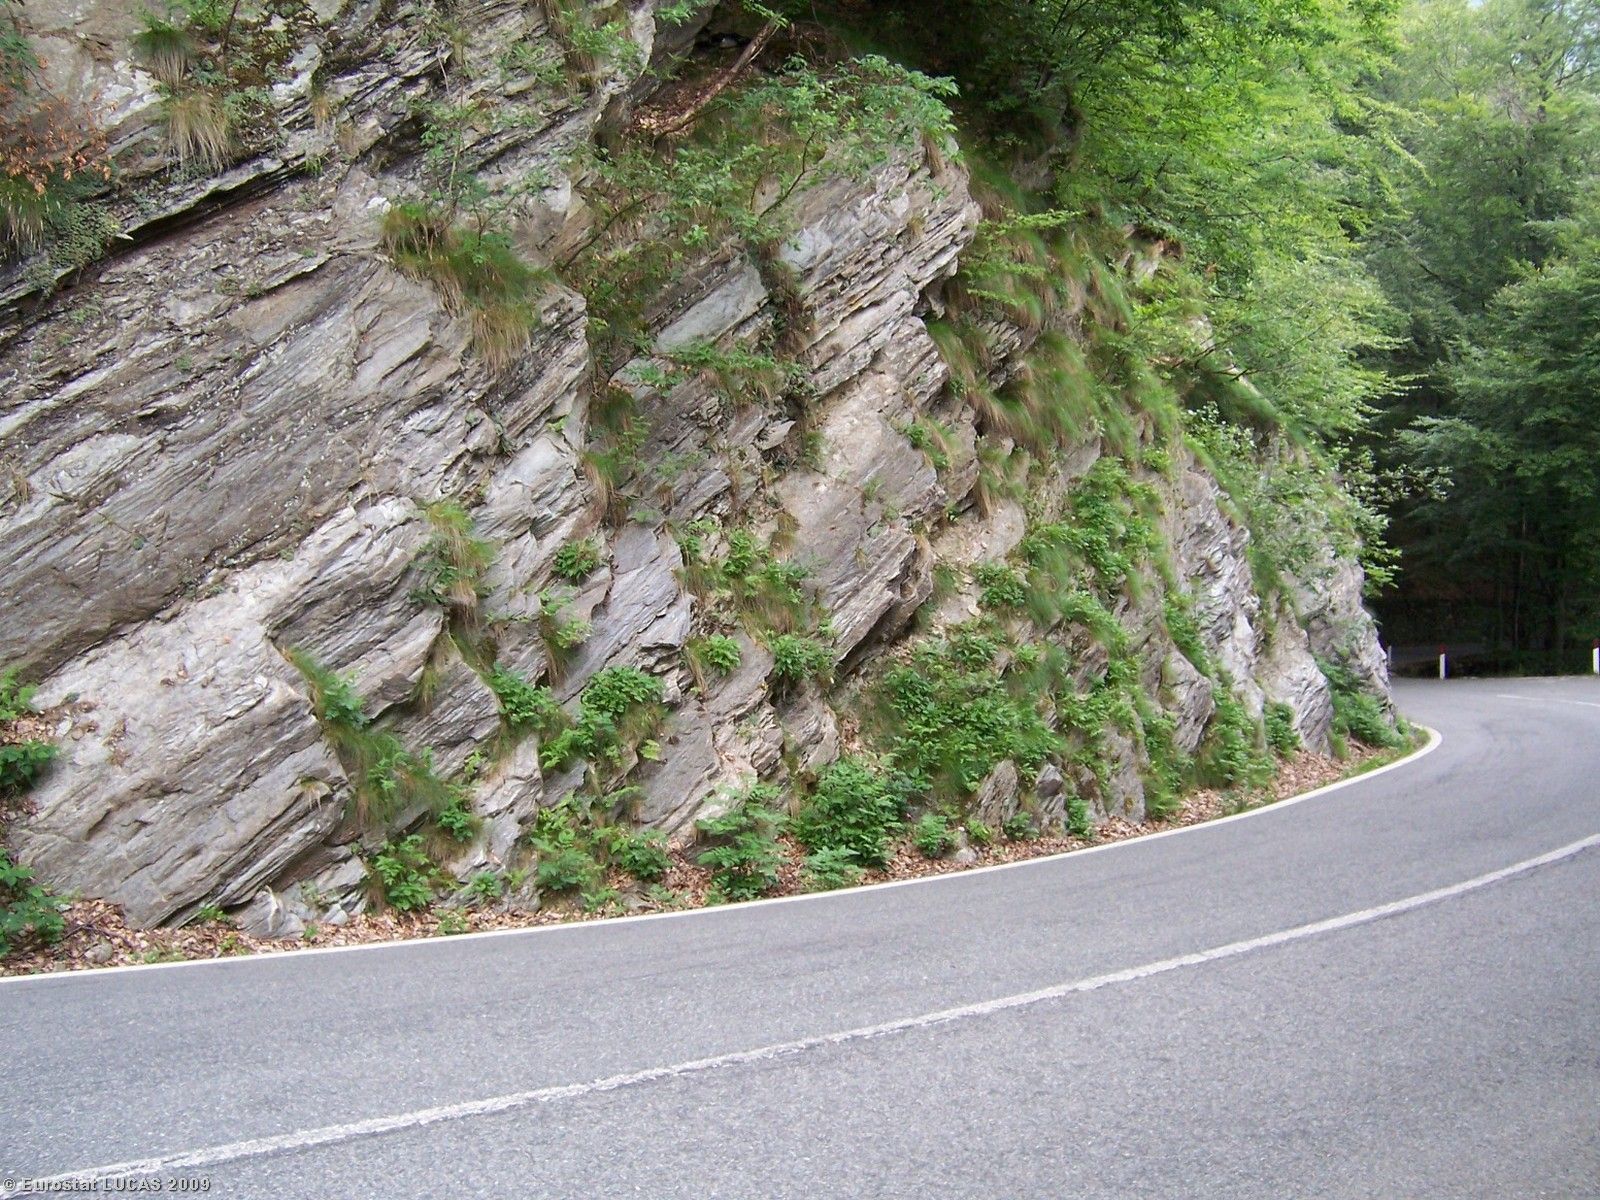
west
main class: Woodland
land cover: Broadleaved woodland
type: mountainous beech forest
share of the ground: > 75 %
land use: Unused
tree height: > 5 m
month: July
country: IT
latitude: 45.2012
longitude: 7.3691
